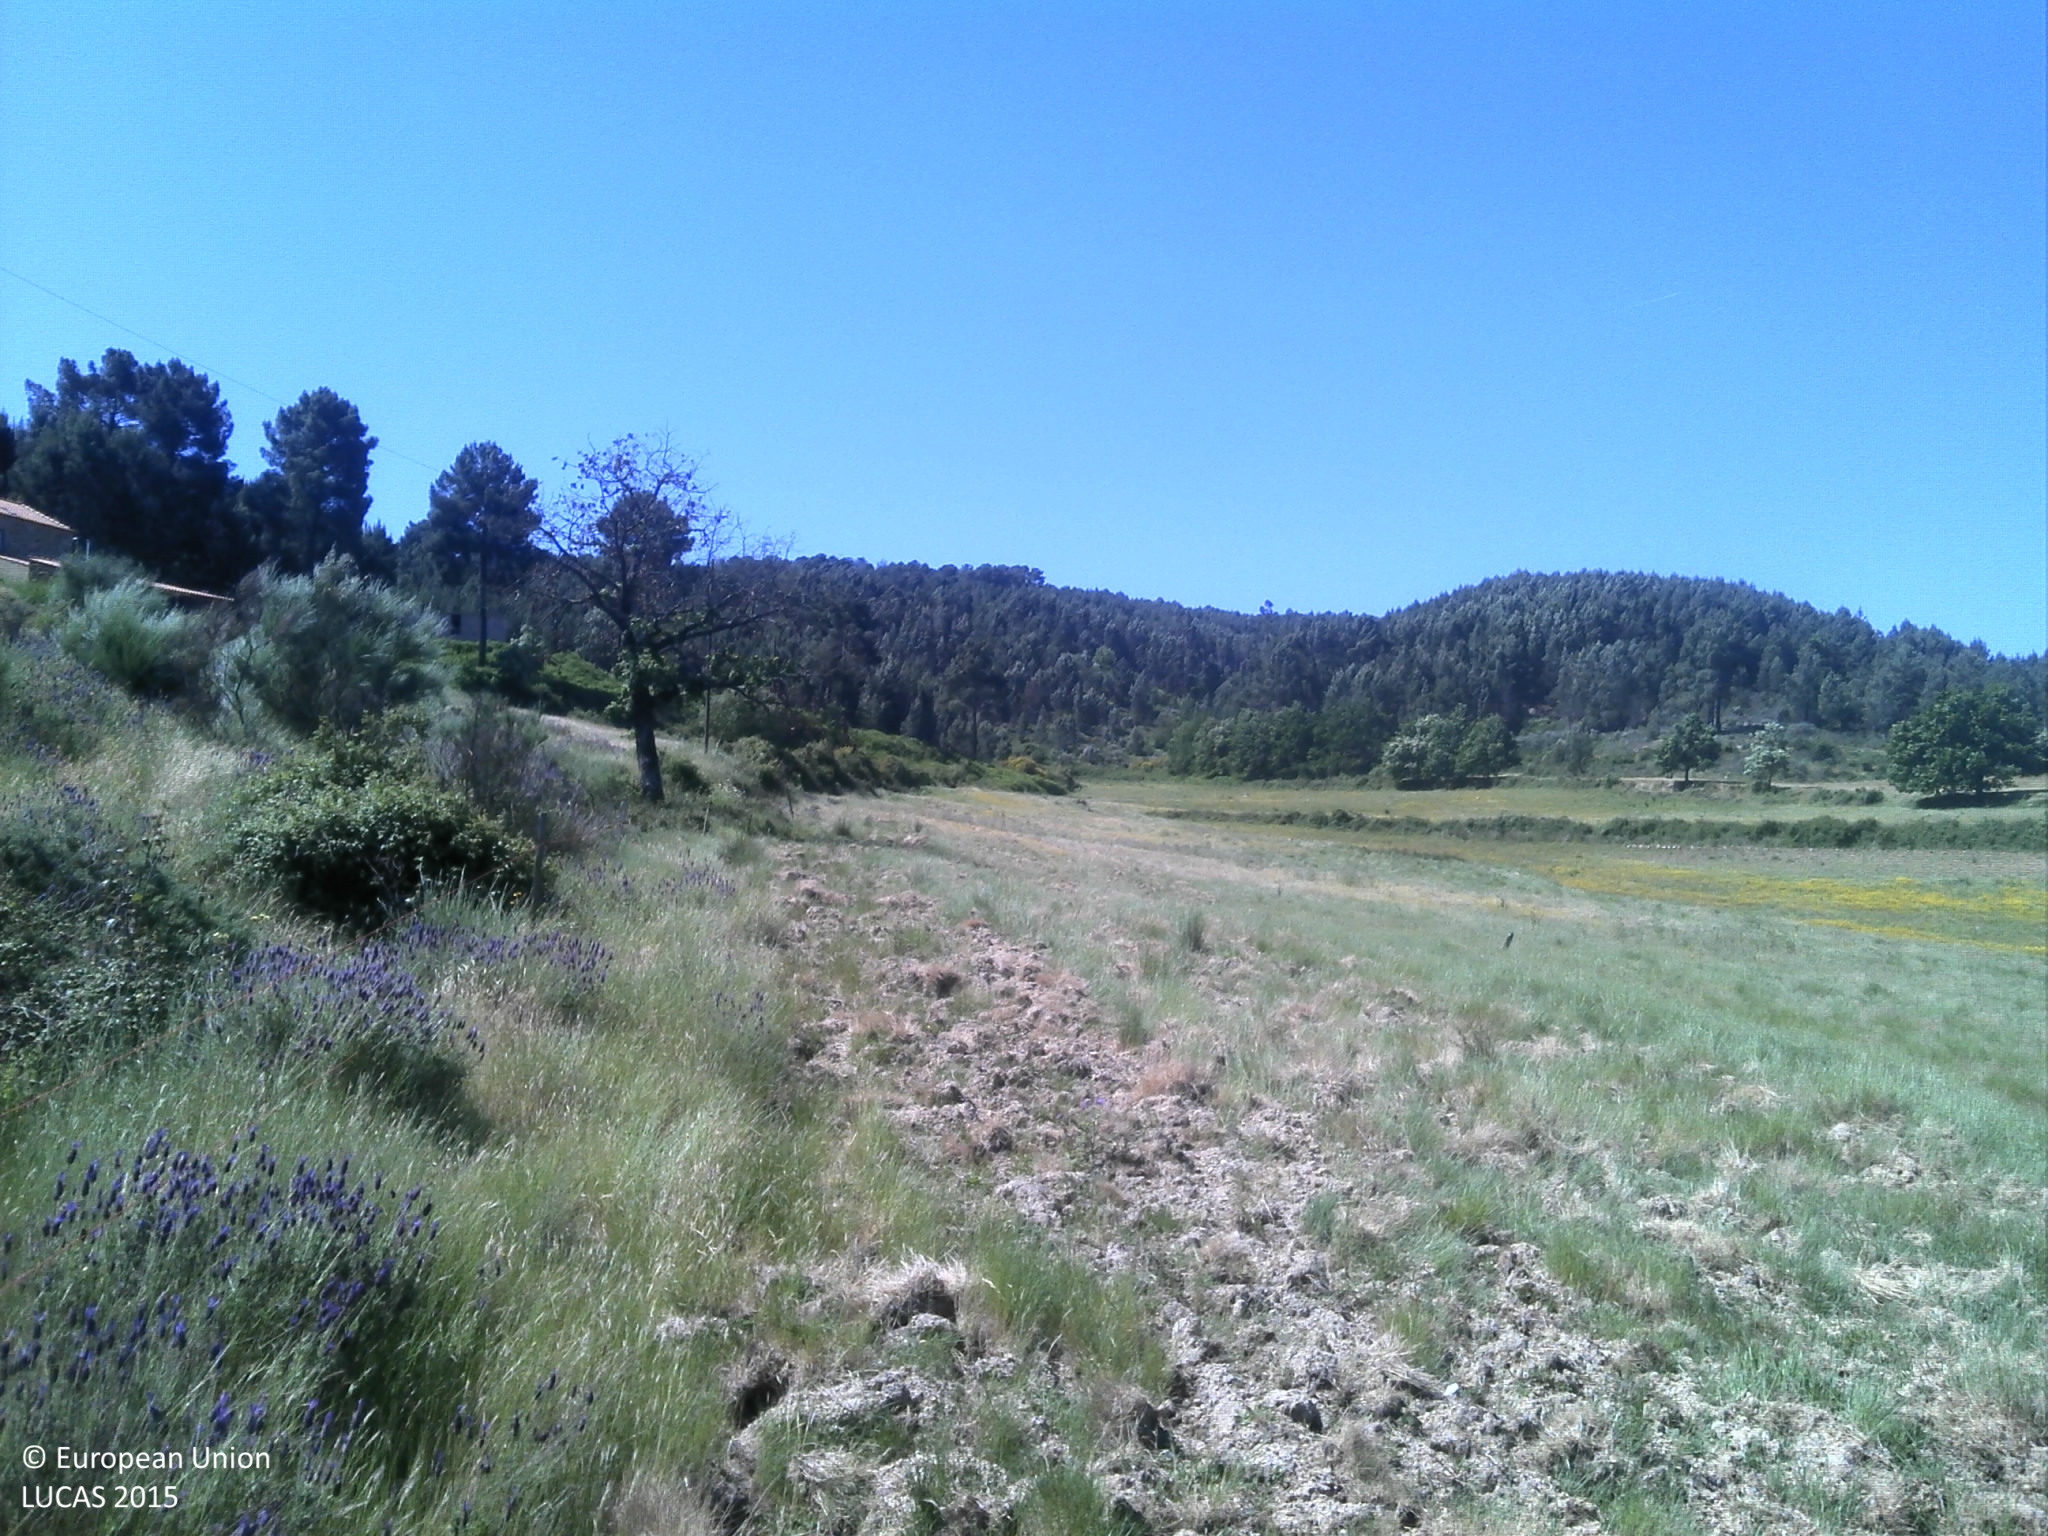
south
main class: Grassland
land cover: Grassland without tree/shrub cover
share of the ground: 25 - 50 %
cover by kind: unconsolidated bare surface 60 %, herbaceous plants 40 %
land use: Agriculture (excluding fallow land and kitchen gardens)
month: May
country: PT
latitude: 40.4102
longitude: -7.7326
